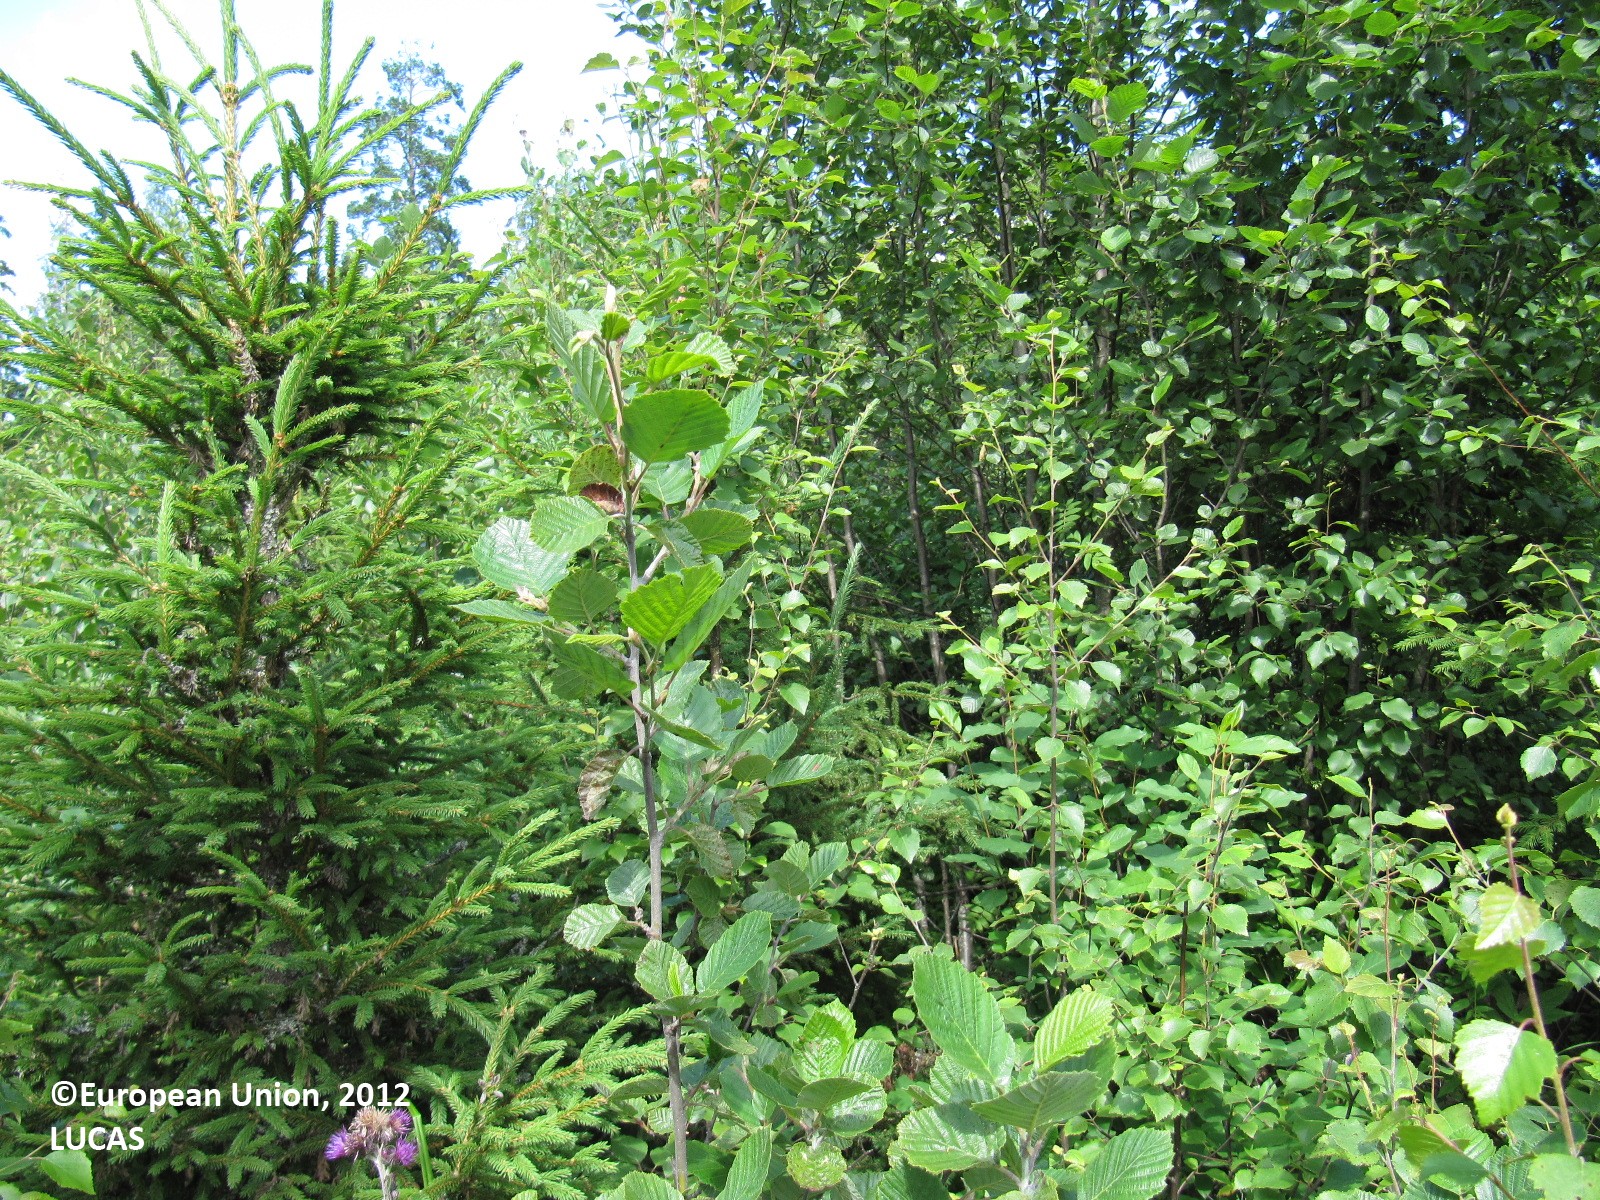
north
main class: Woodland
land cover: Broadleaved woodland
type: boreal forest
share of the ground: > 75 %
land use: Forestry
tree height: < 5 m
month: July
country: FI
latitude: 60.9800
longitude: 24.1961
